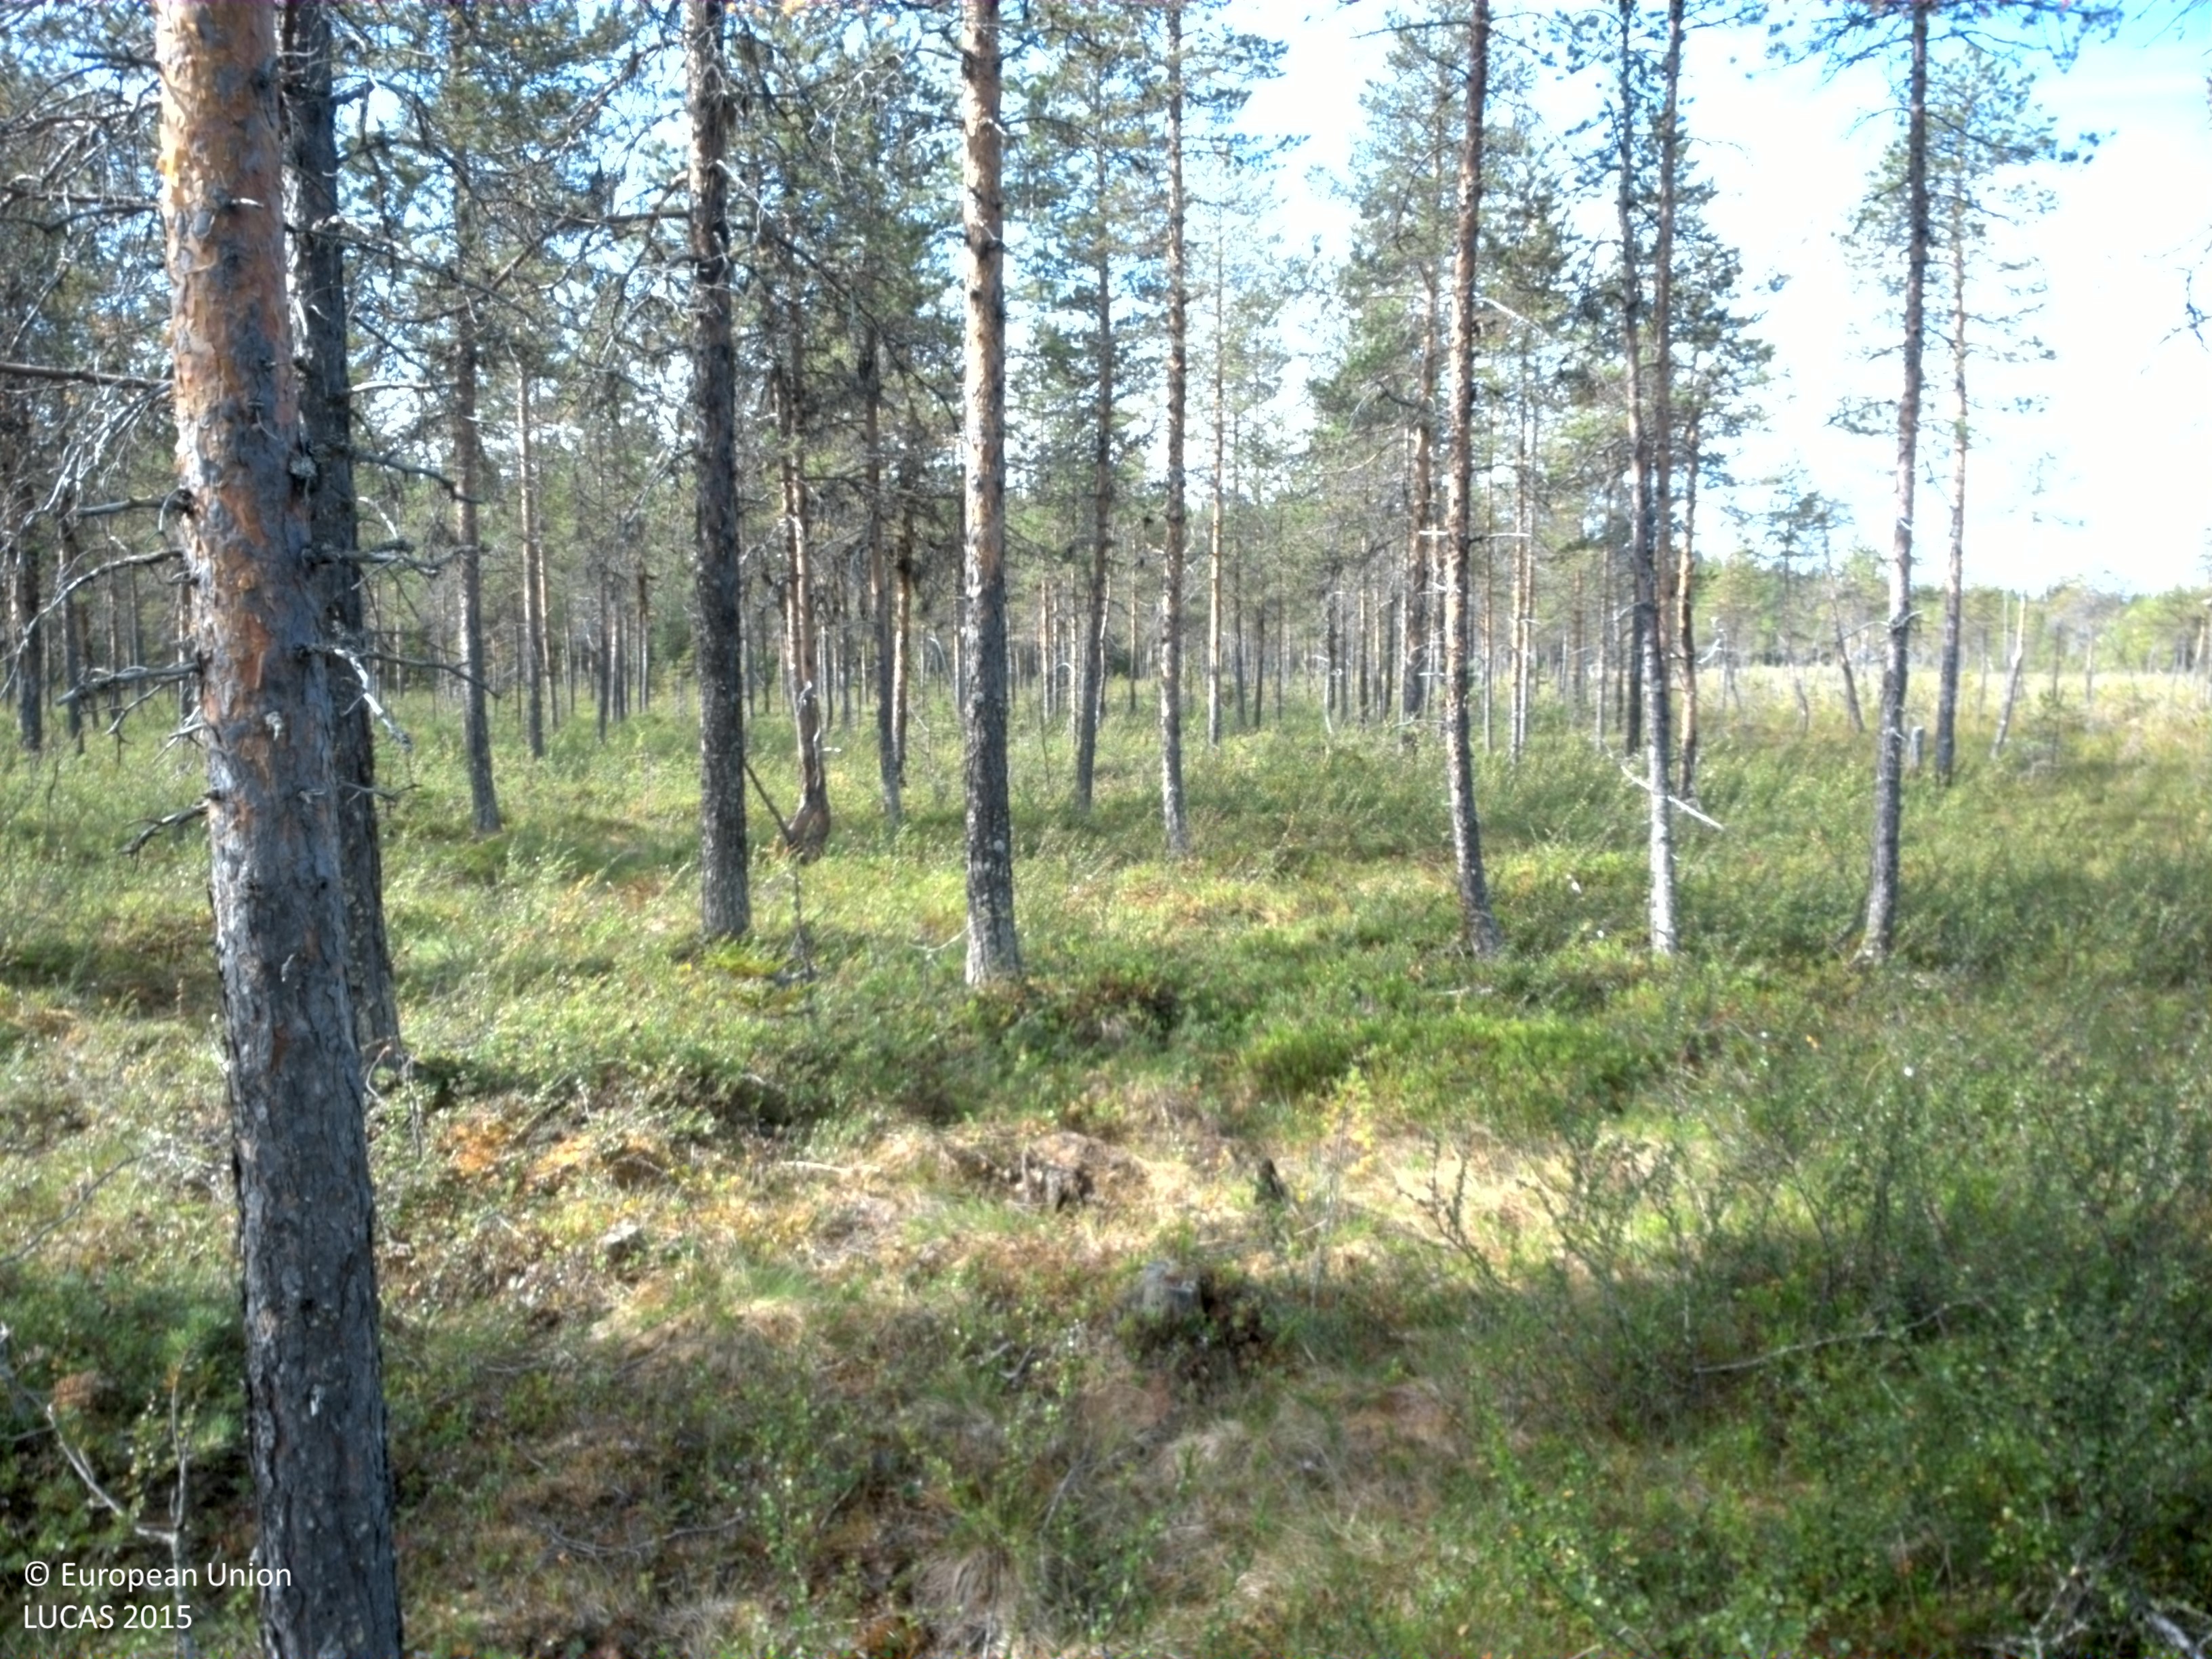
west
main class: Woodland
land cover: Pine dominated coniferous woodland
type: boreal forest
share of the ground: 10 - 25 %
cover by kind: shrubs 65 %, coniferous forest trees 20 %, lichens and mosses 10 %, herbaceous plants 5 %
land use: Forestry
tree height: > 5 m
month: August
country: SE
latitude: 64.7022
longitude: 16.4475
